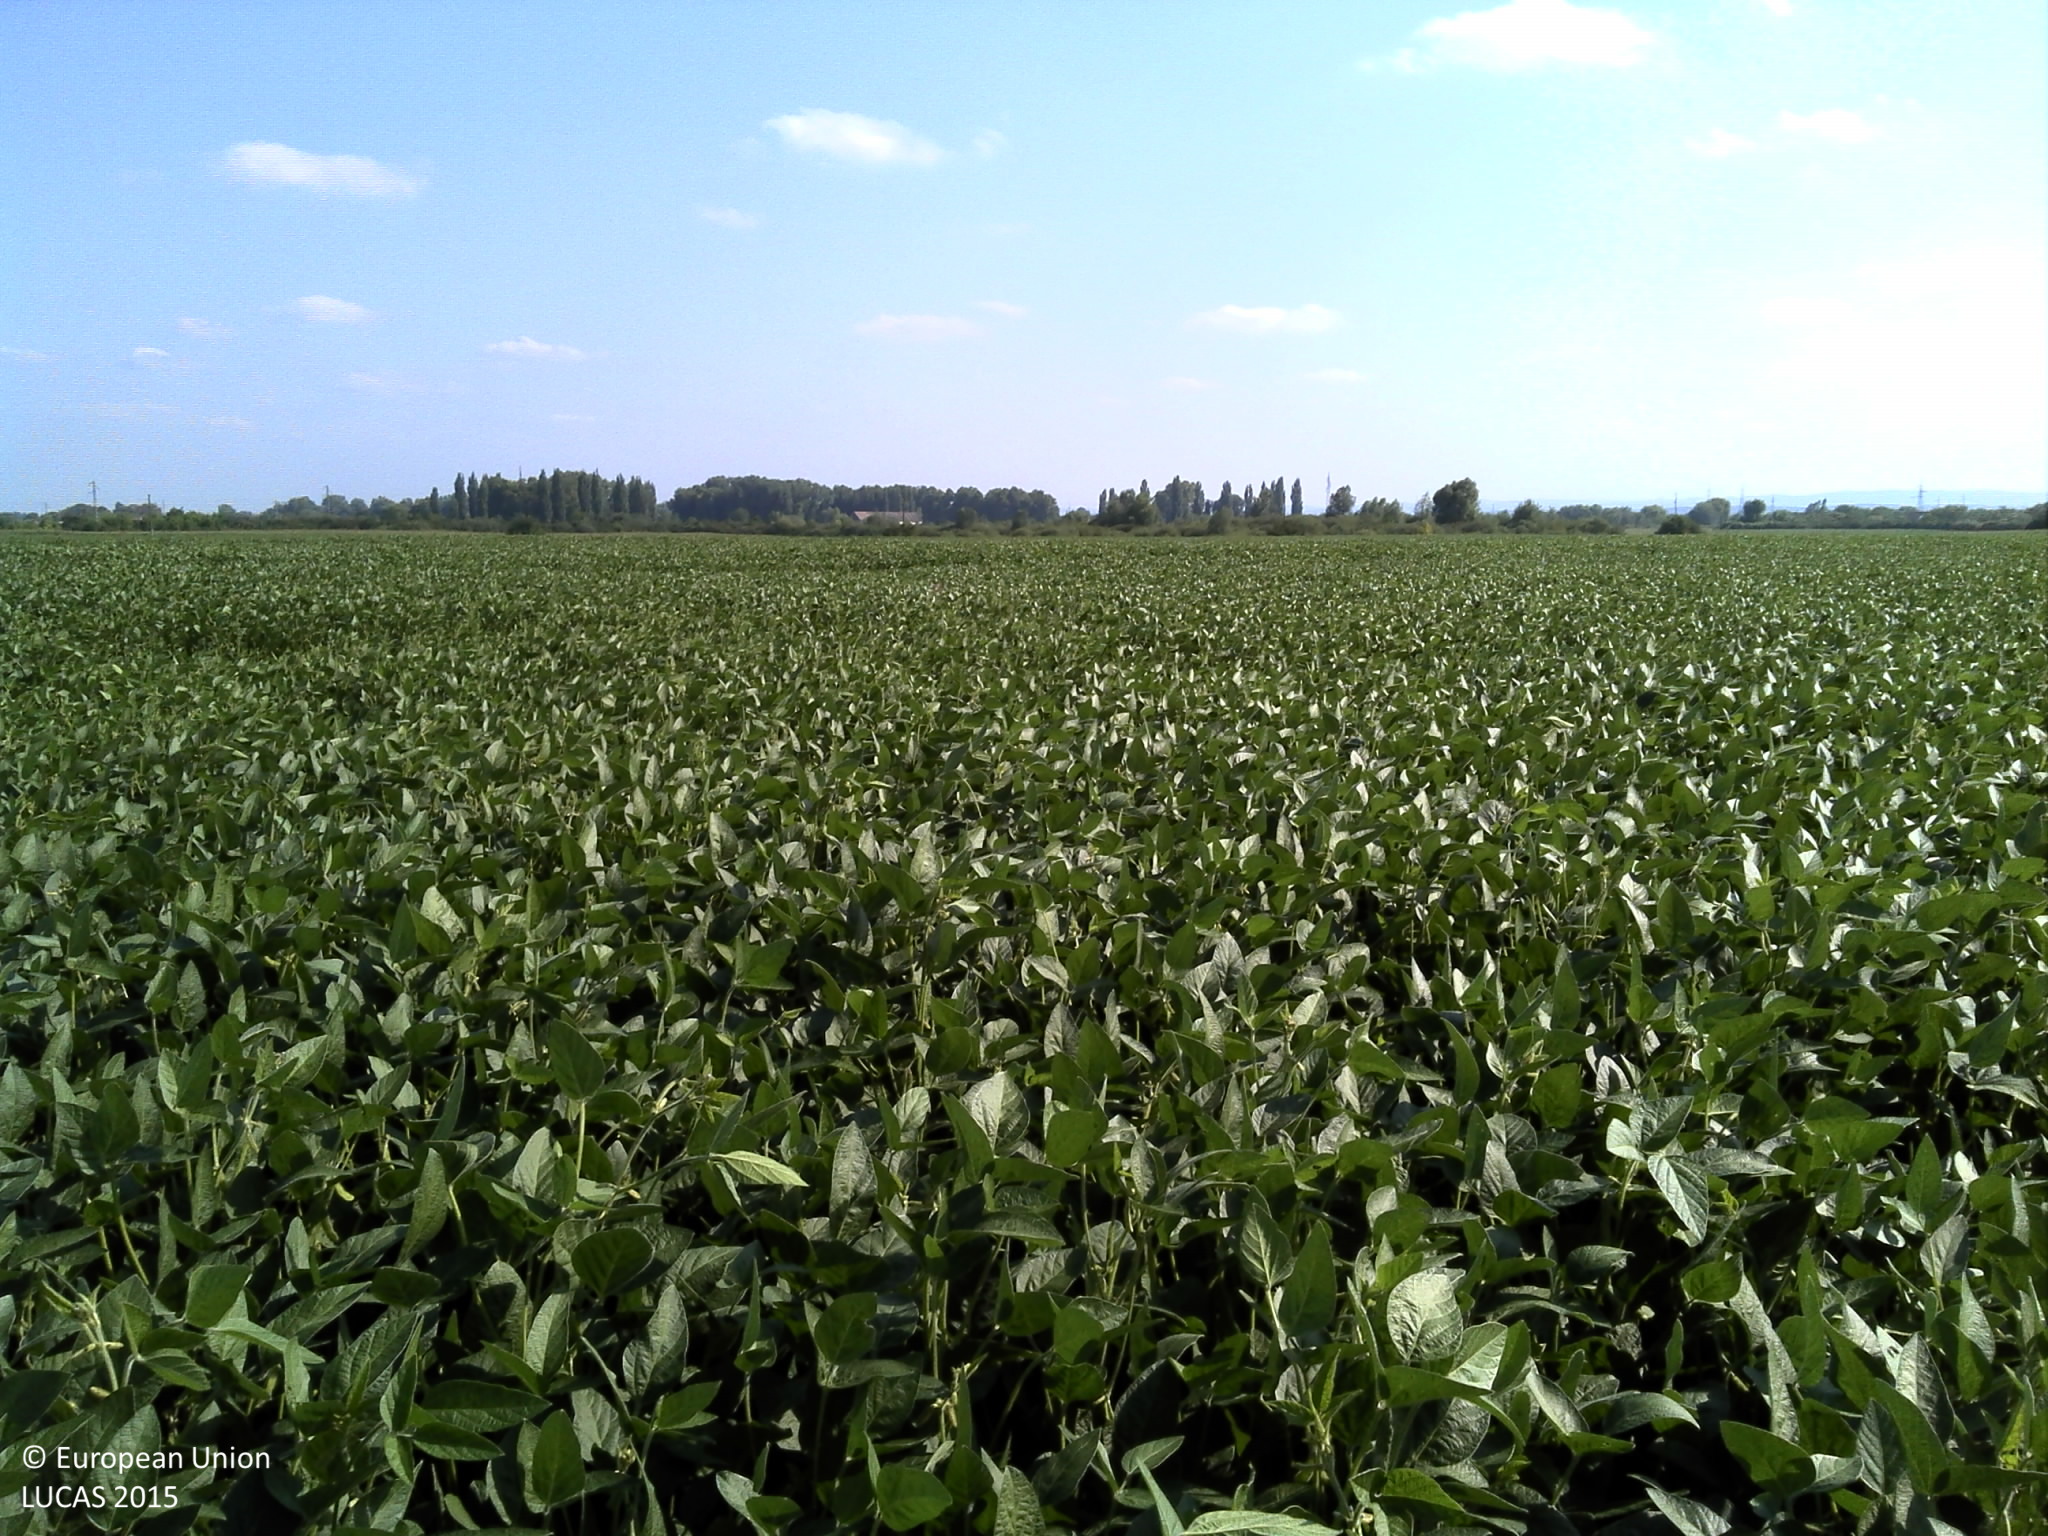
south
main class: Cropland
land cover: Soya
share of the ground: > 75 %
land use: Agriculture (excluding fallow land and kitchen gardens)
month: August
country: HR
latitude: 45.4709
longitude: 16.4318
